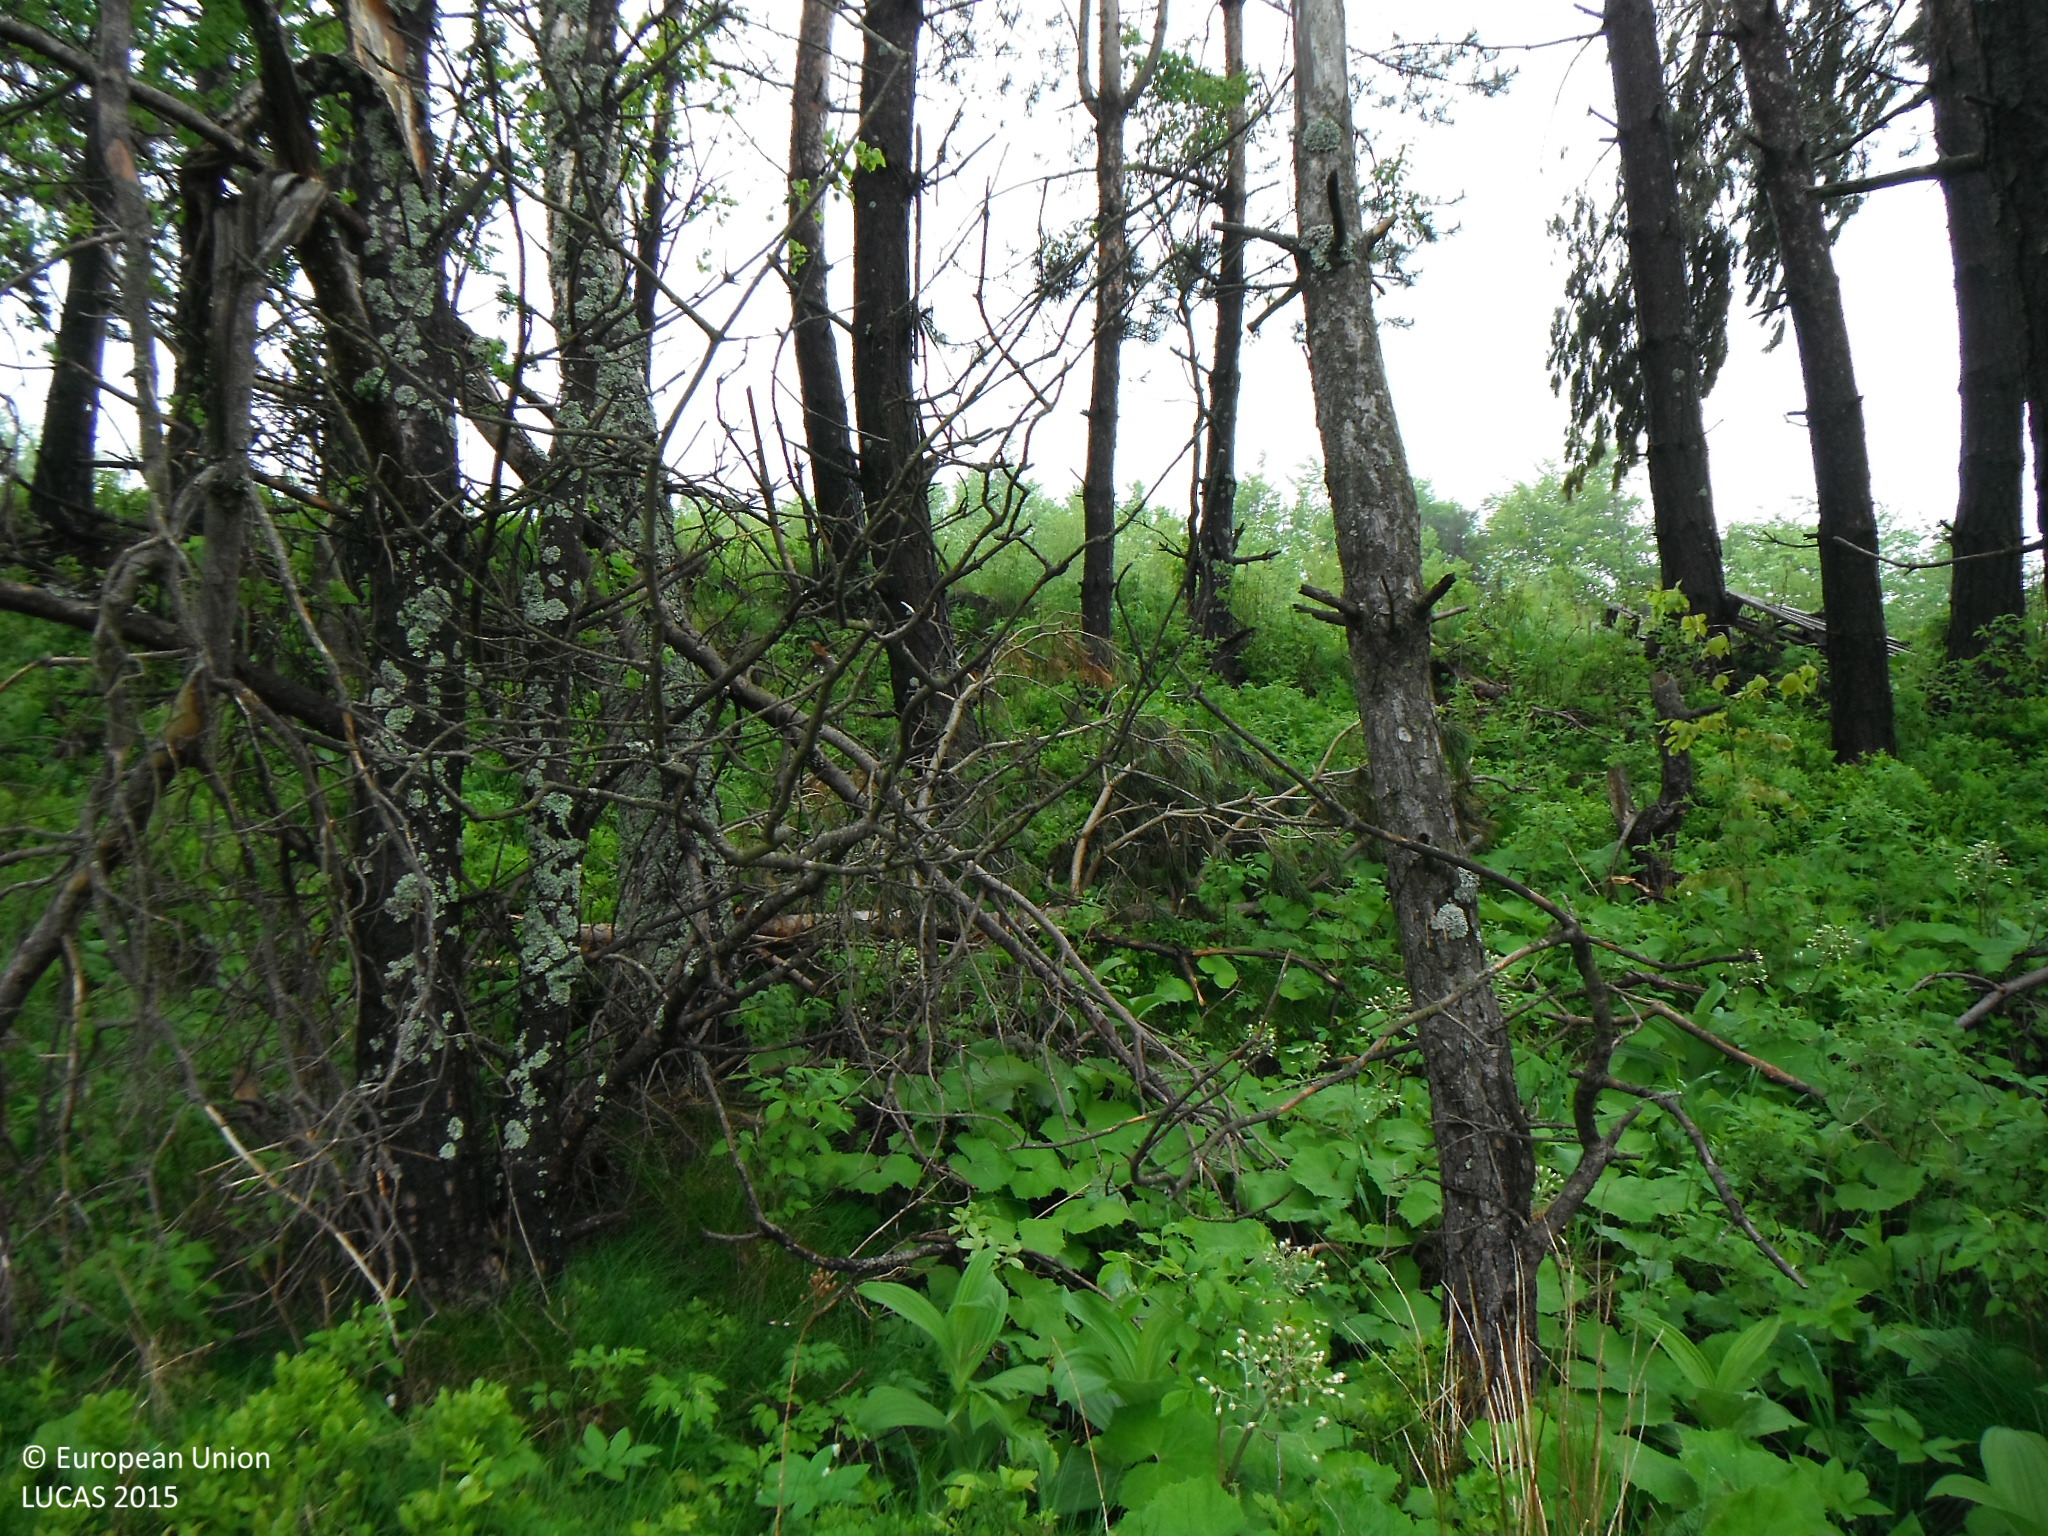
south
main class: Grassland
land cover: Spontaneously vegetated surfaces
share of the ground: > 75 %
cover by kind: herbaceous plants 100 %
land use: Sport
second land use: Amenities, museums, leisure
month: May
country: SK
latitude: 49.1645
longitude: 21.1388
